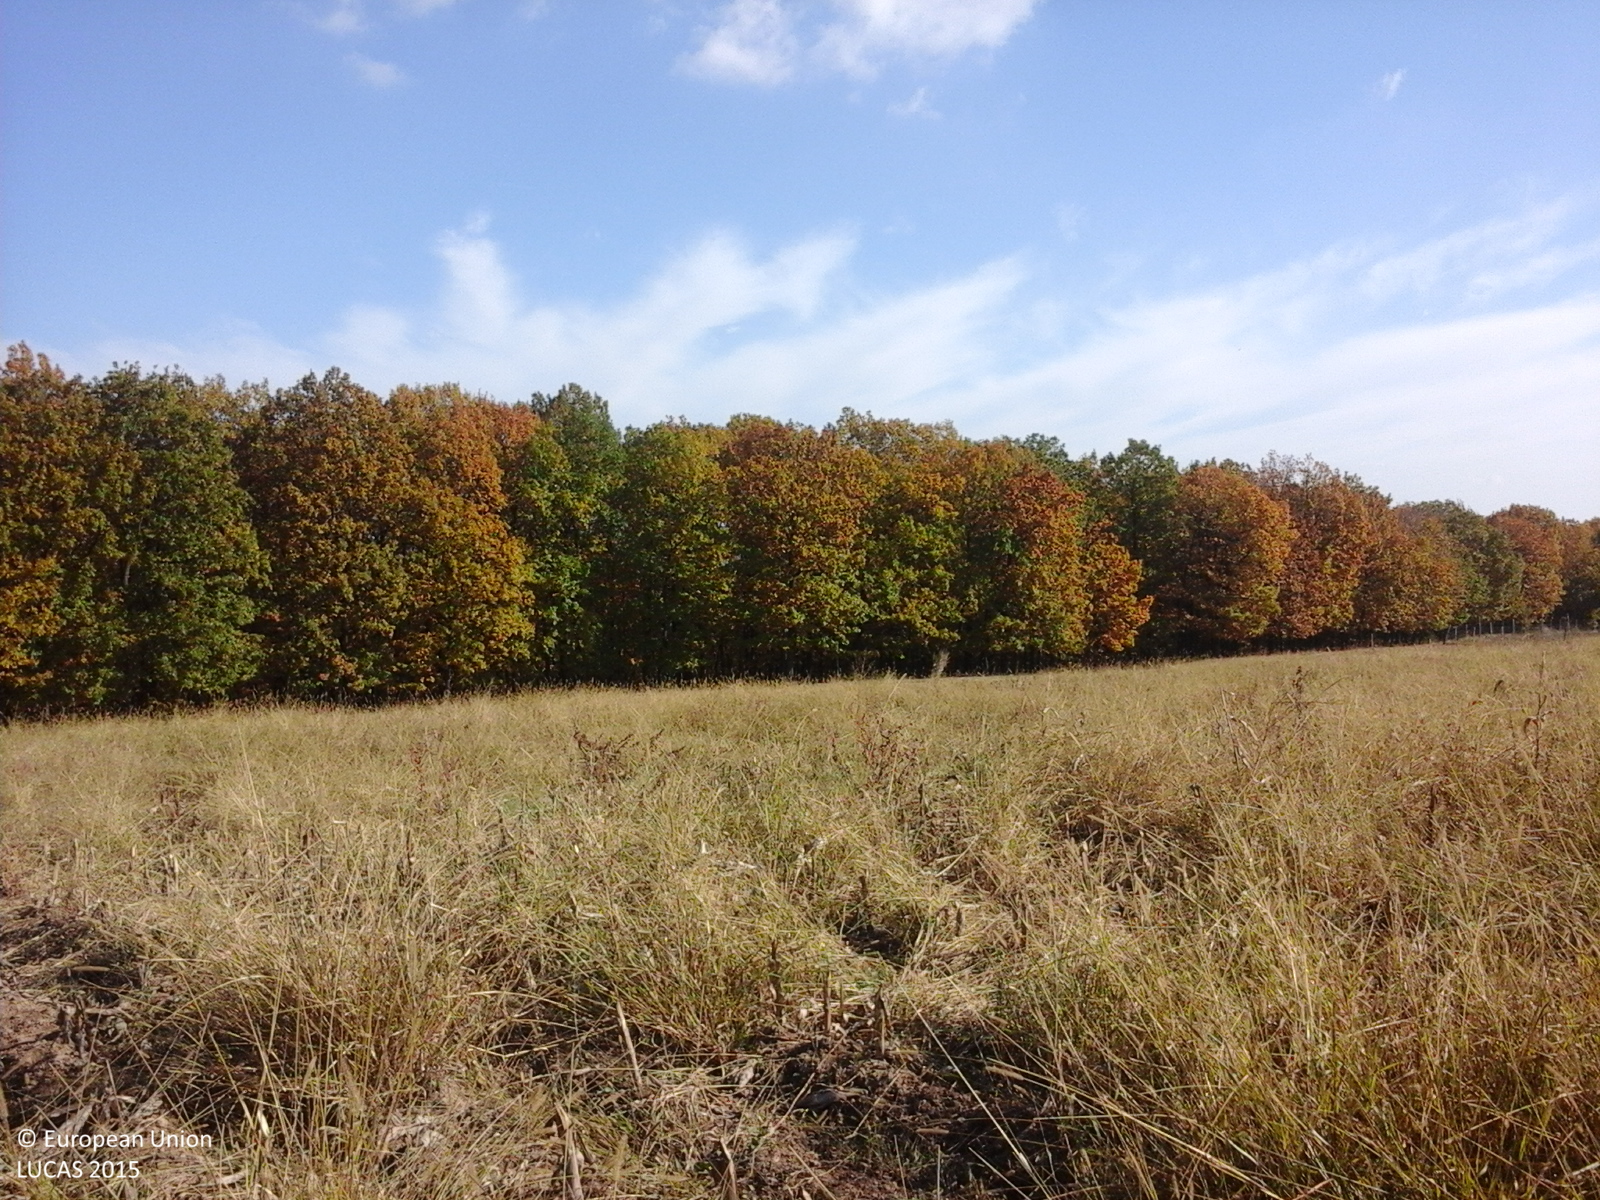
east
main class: Cropland
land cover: Maize
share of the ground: 25 - 50 %
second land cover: Spontaneously vegetated surfaces
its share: > 75 %
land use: Agriculture (excluding fallow land and kitchen gardens)
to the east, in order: Maize; Spontaneously vegetated surfaces; Broadleaved woodland
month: October
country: RO
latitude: 45.9956
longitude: 27.0726
